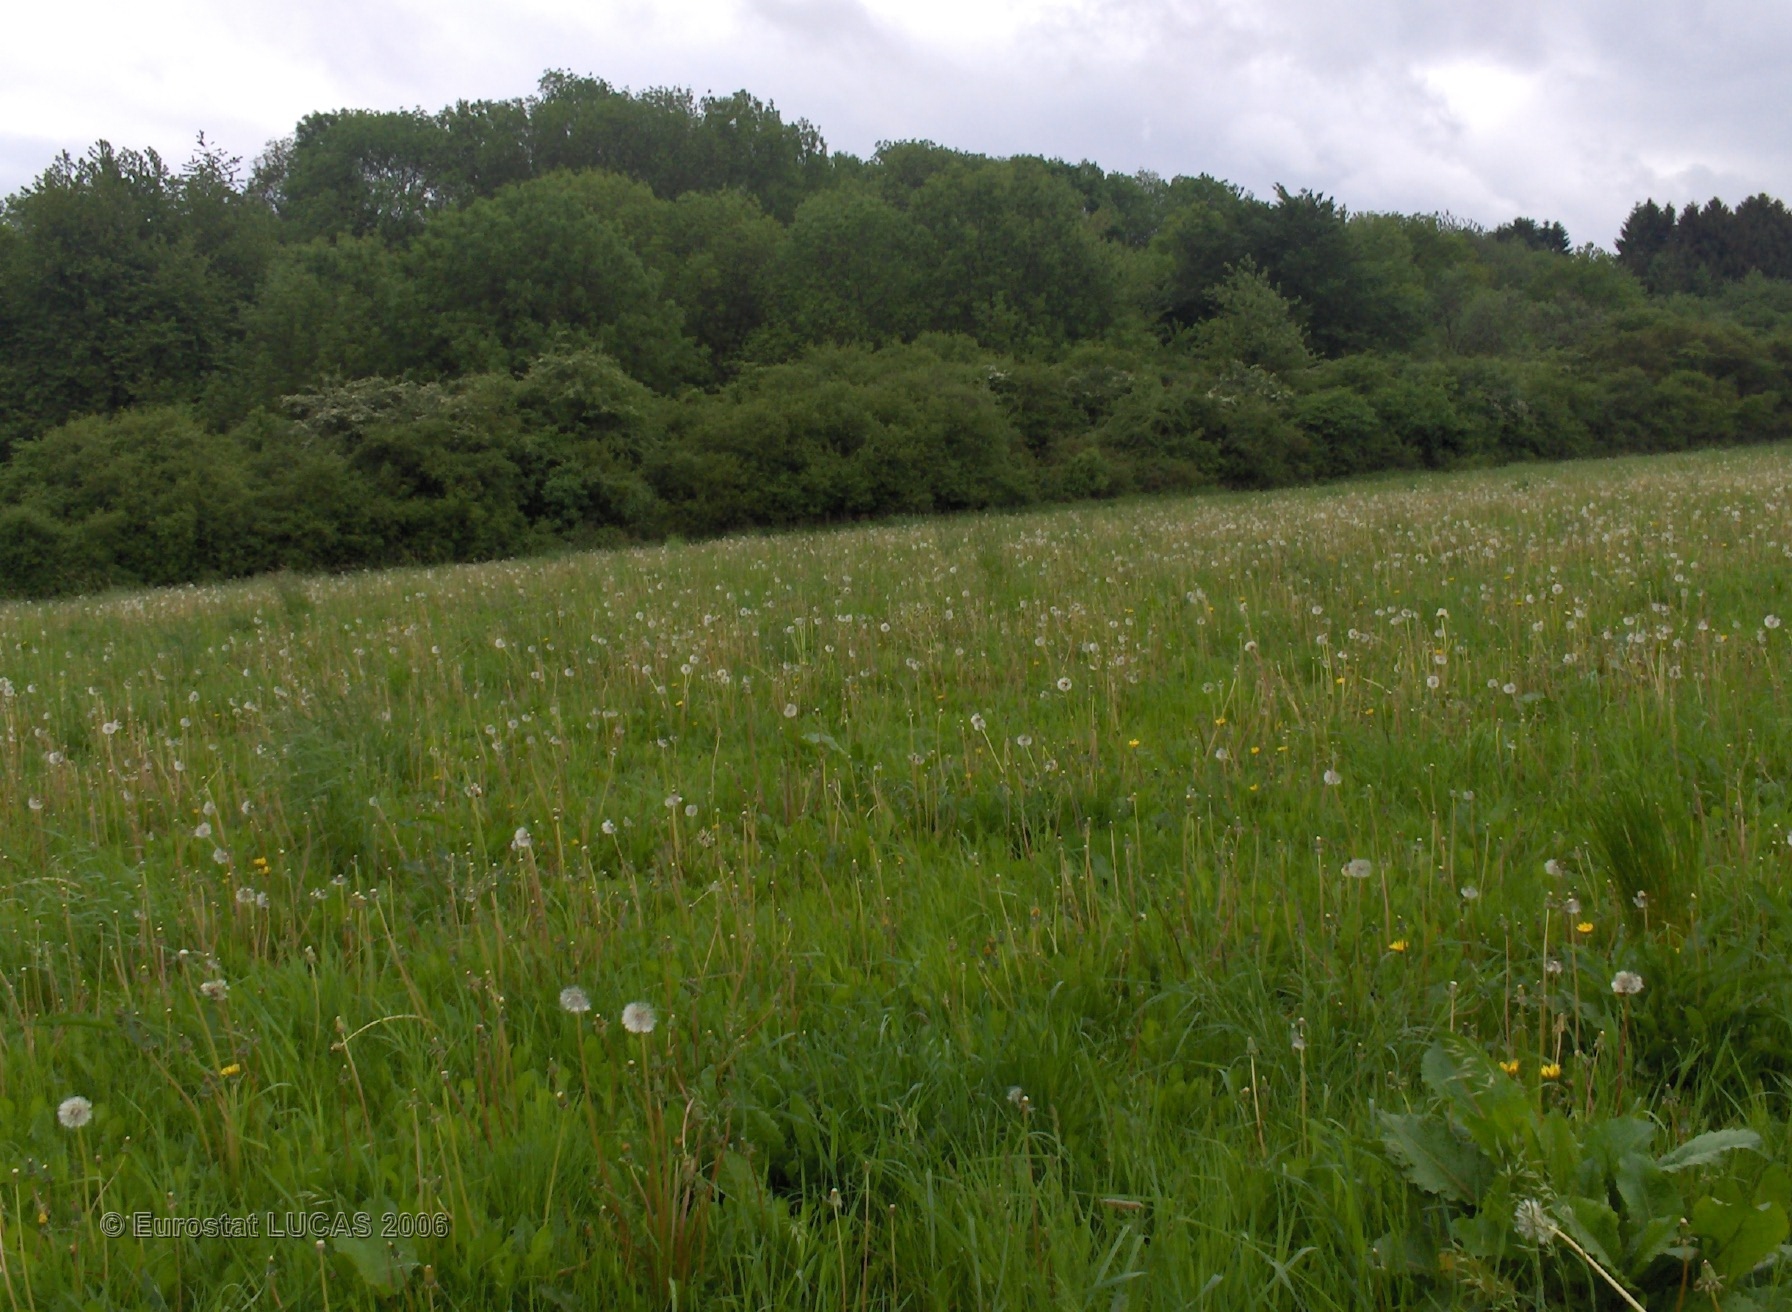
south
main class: Grassland
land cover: Grassland without tree/shrub cover
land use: Agriculture (excluding fallow land and kitchen gardens)
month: May
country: BE
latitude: 50.2663
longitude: 5.2700
